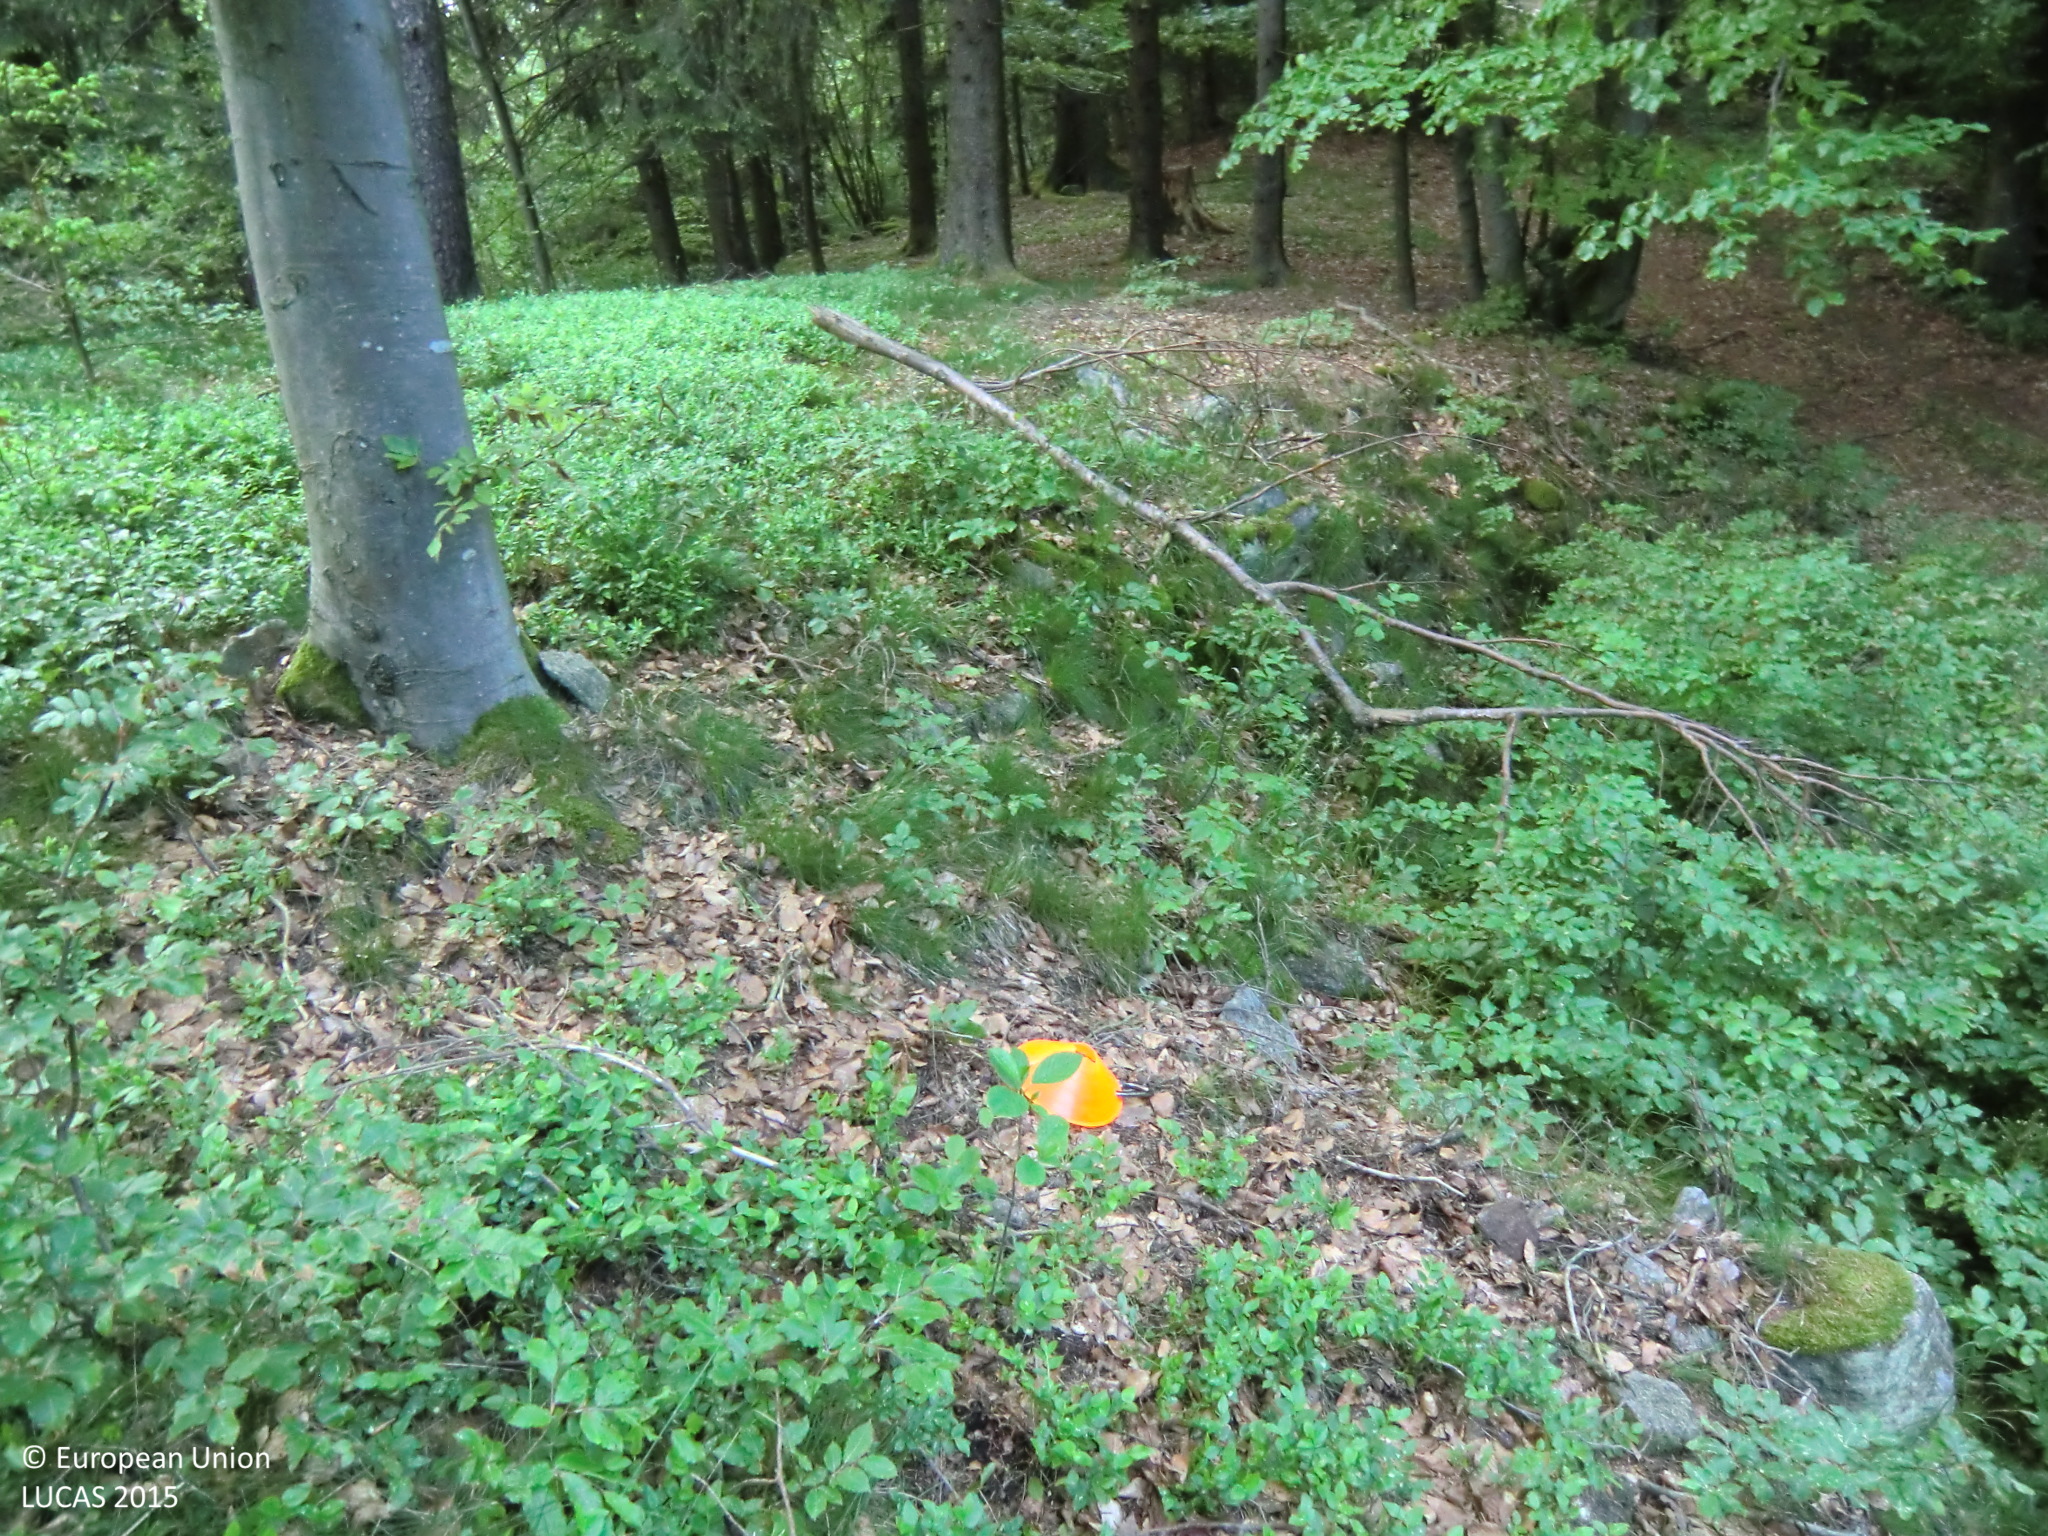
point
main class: Woodland
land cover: Other mixed woodland
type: hemiboreal forest and nemoral coniferous forest and mixed broadleaved-coniferous forest
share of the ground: 50 - 75 %
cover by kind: coniferous forest trees 30 %, broadleaved forest trees 30 %, shrubs 20 %, herbaceous plants 20 %
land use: Forestry
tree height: > 5 m
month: May
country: AT
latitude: 48.3927
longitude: 14.2814
